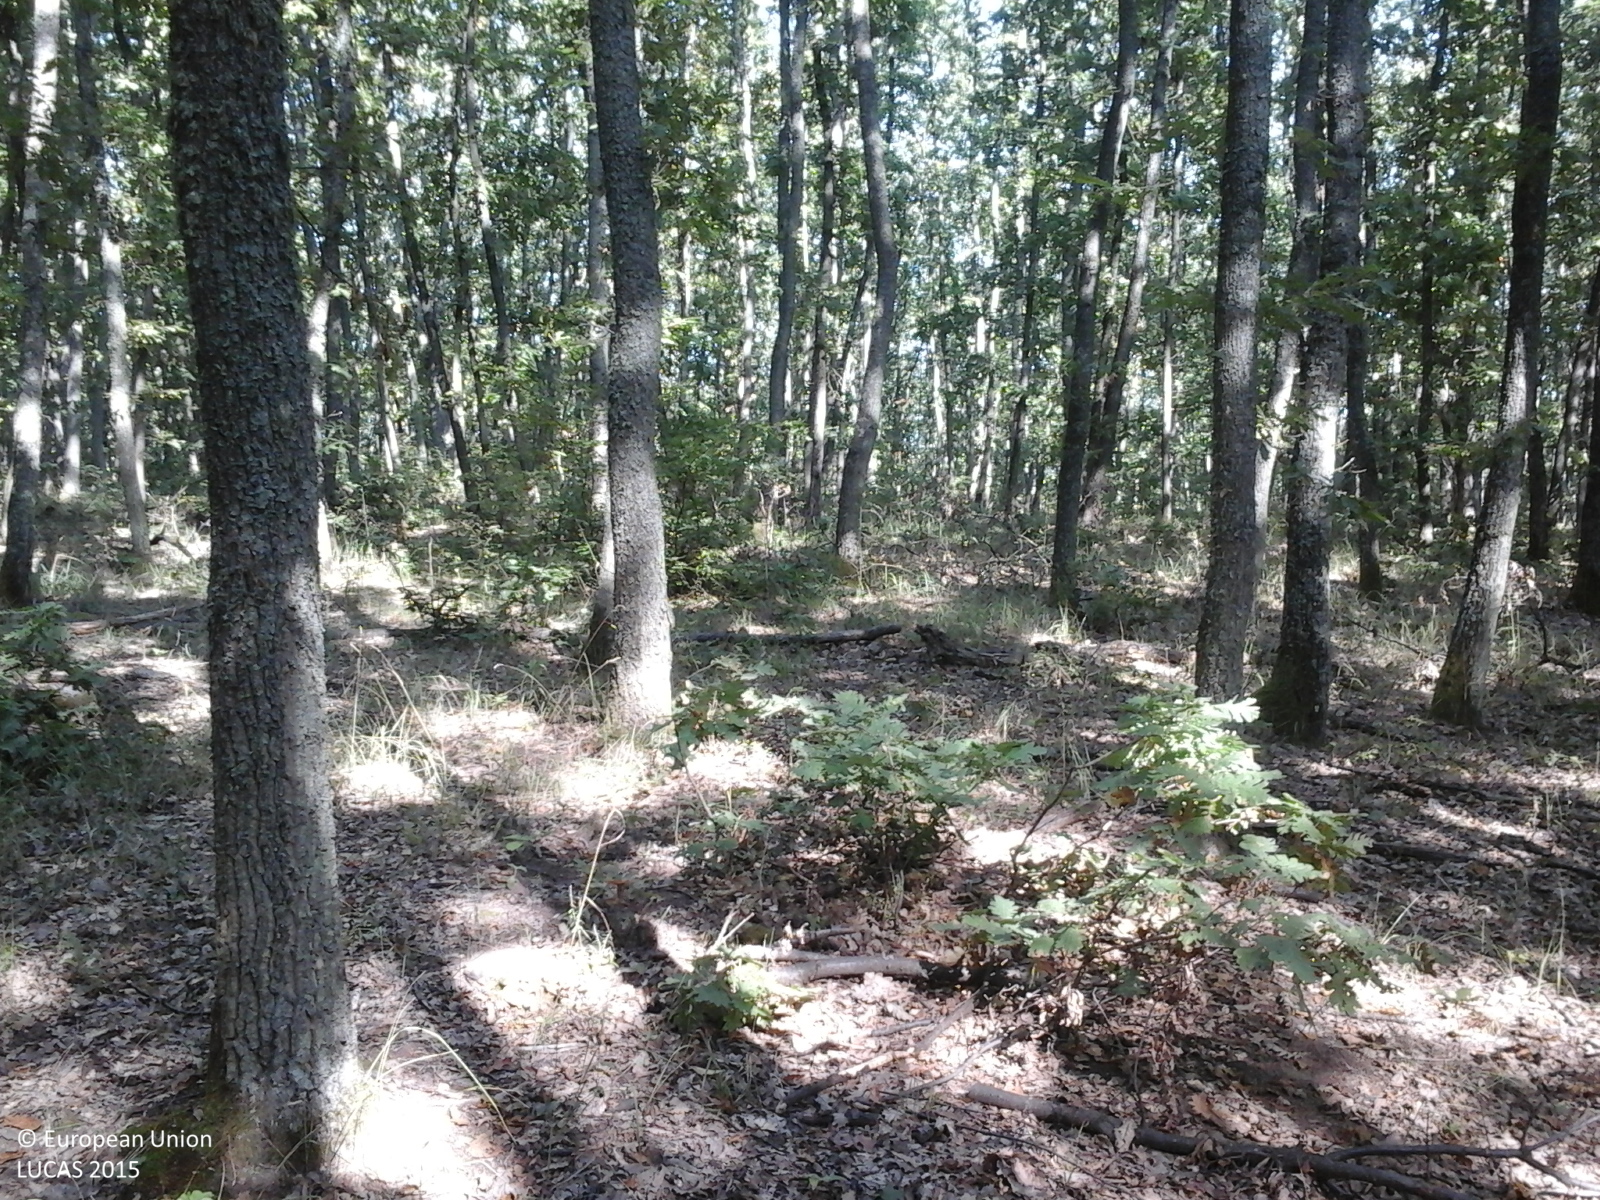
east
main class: Woodland
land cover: Broadleaved woodland
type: acidophilous oak and oak-birch forest
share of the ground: > 75 %
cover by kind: broadleaved forest trees 100 %
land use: Forestry
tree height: > 5 m
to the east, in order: Broadleaved woodland; Tracks; Broadleaved woodland; Ditches and canals; Broadleaved woodland
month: August
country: RO
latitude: 45.9654
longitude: 21.6638
